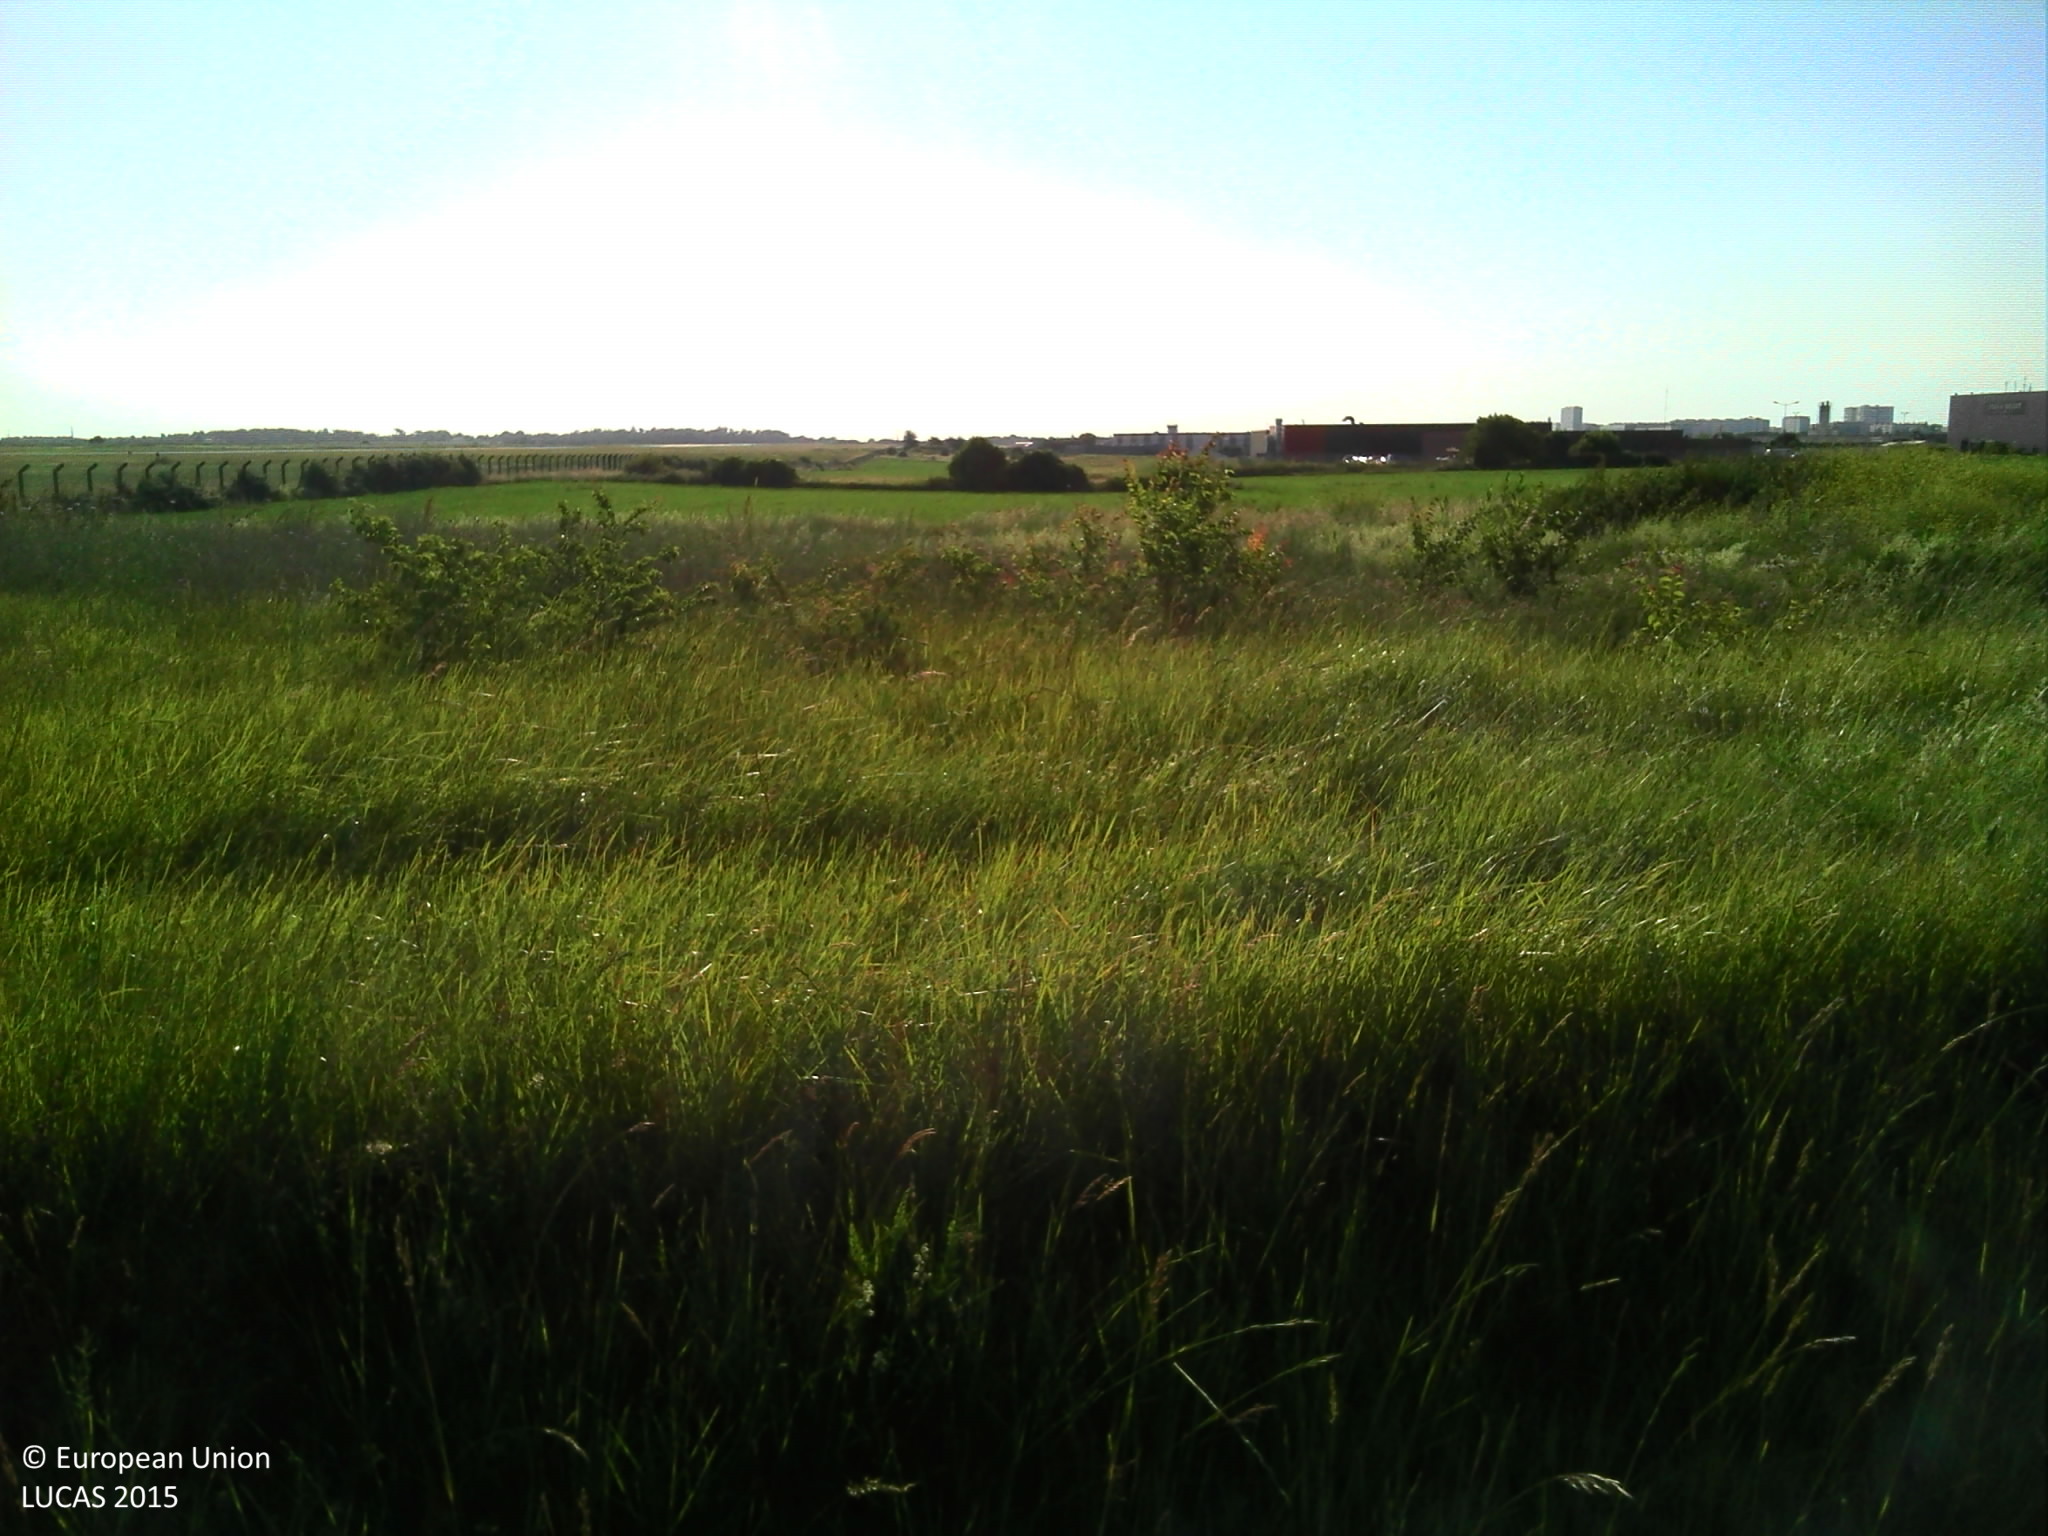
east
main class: Grassland
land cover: Spontaneously vegetated surfaces
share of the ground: > 75 %
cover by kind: herbaceous plants 95 %, shrubs 5 %
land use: Road transport
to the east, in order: Spontaneously vegetated surfaces; Ditches and canals; Grassland with sparse tree/shrub cover; Other cereals; Grassland with sparse tree/shrub cover; Other cereals
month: June
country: FR
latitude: 46.1778
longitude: -1.2119
